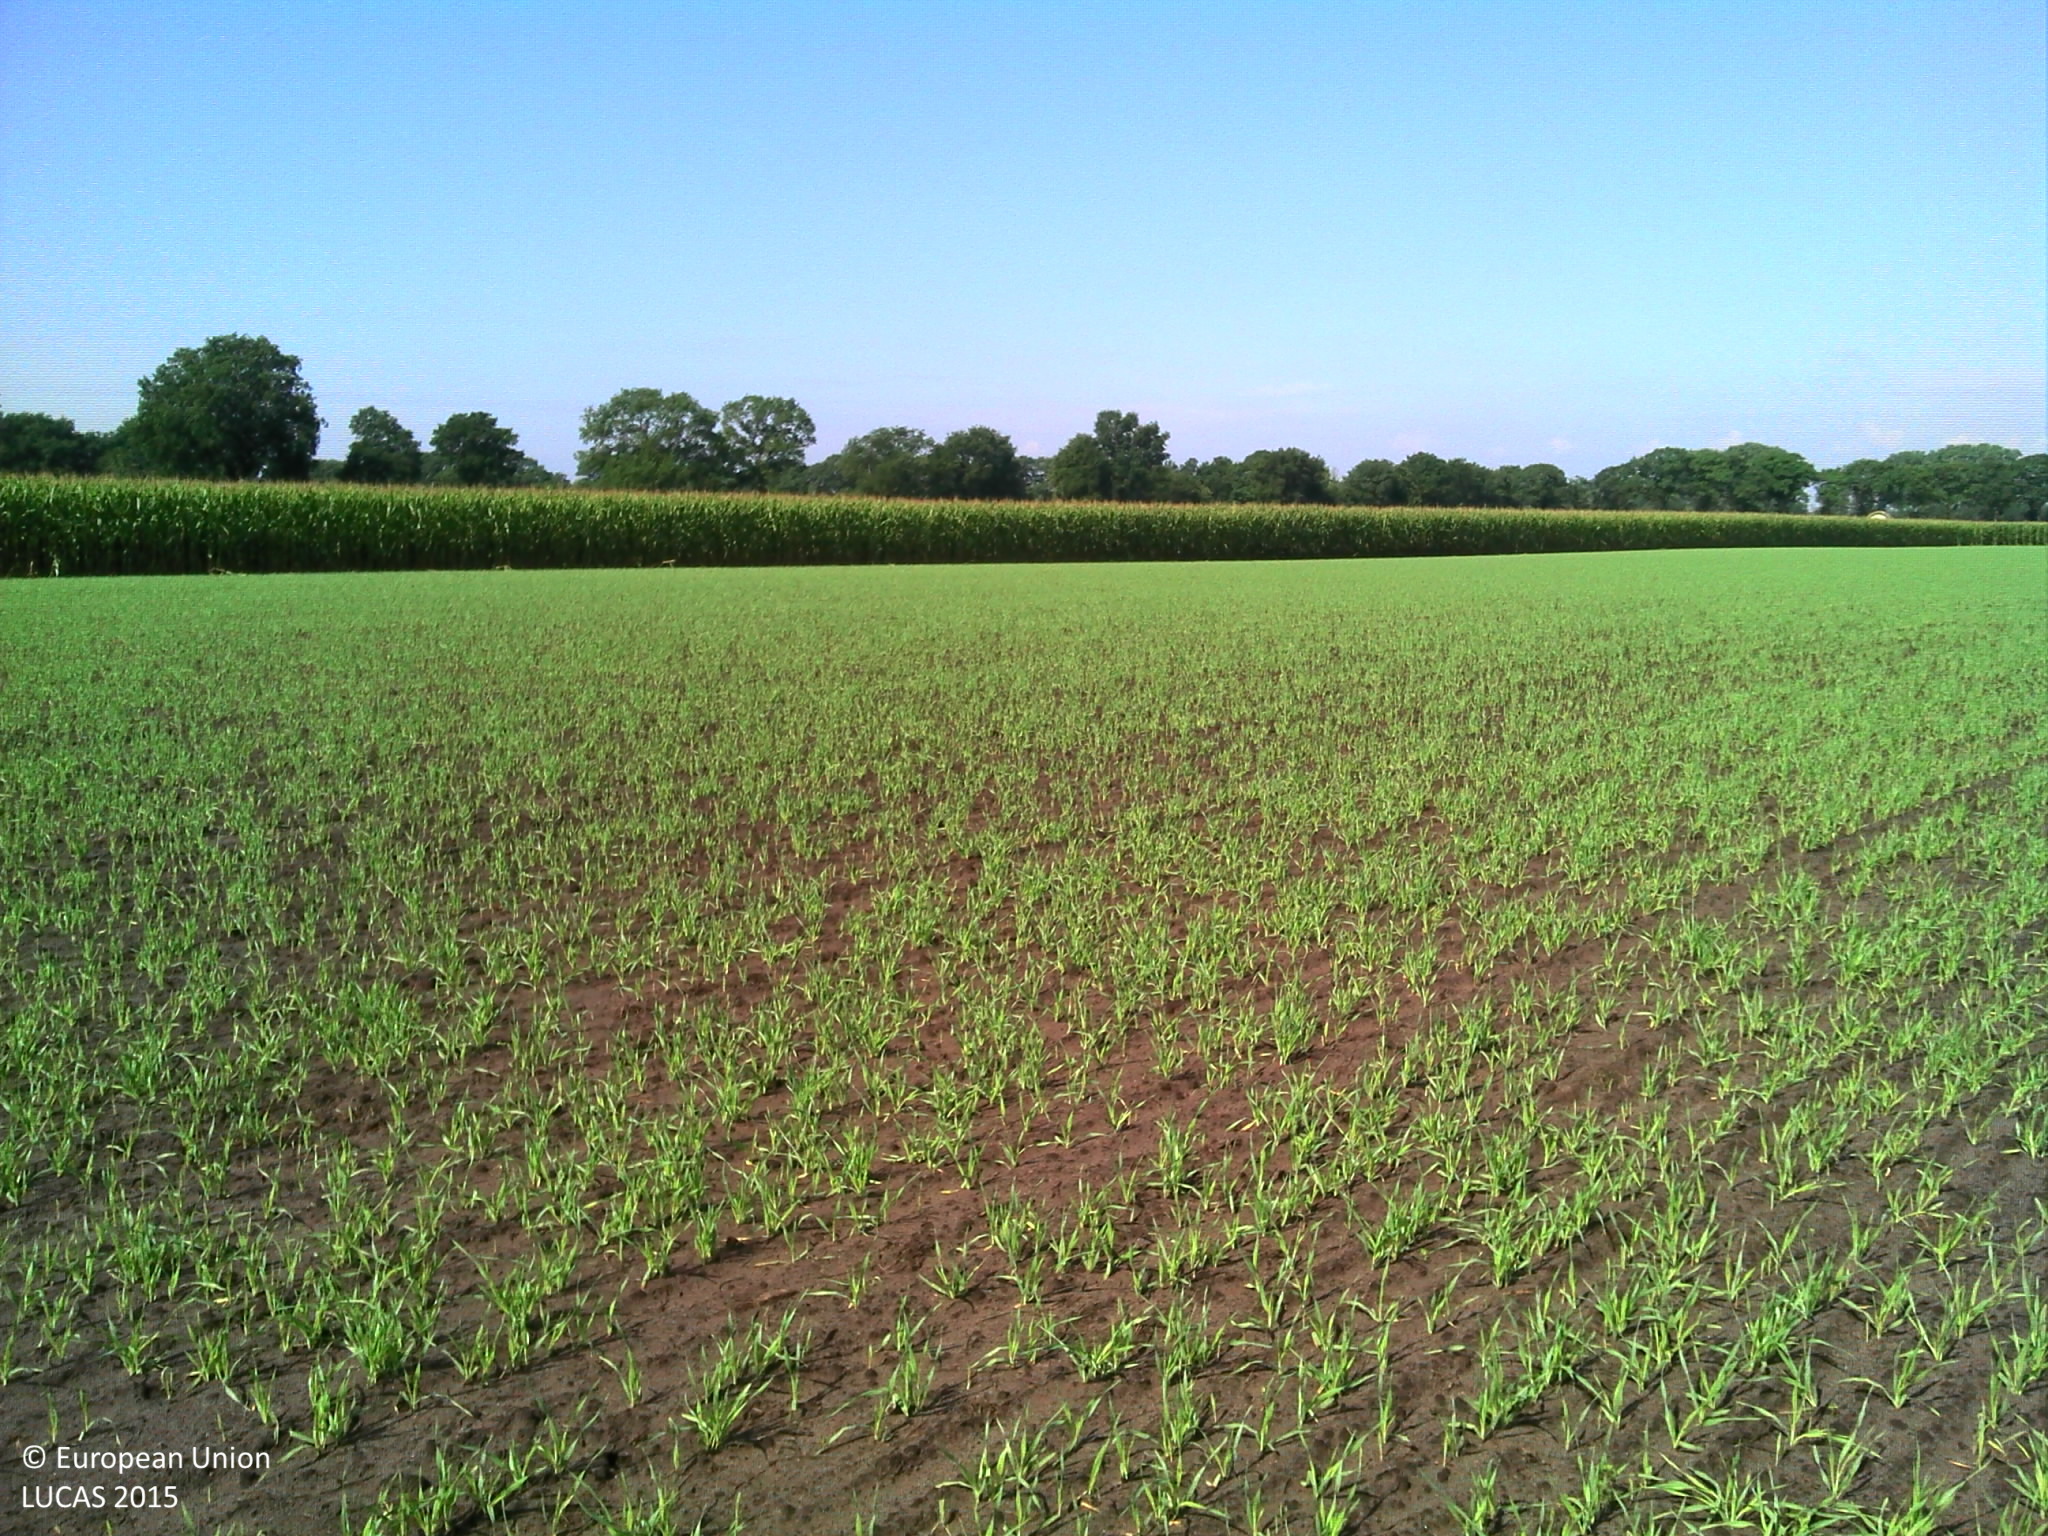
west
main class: Cropland
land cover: Common wheat
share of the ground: < 10 %
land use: Agriculture (excluding fallow land and kitchen gardens)
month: August
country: BE
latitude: 51.2551
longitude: 5.2262
